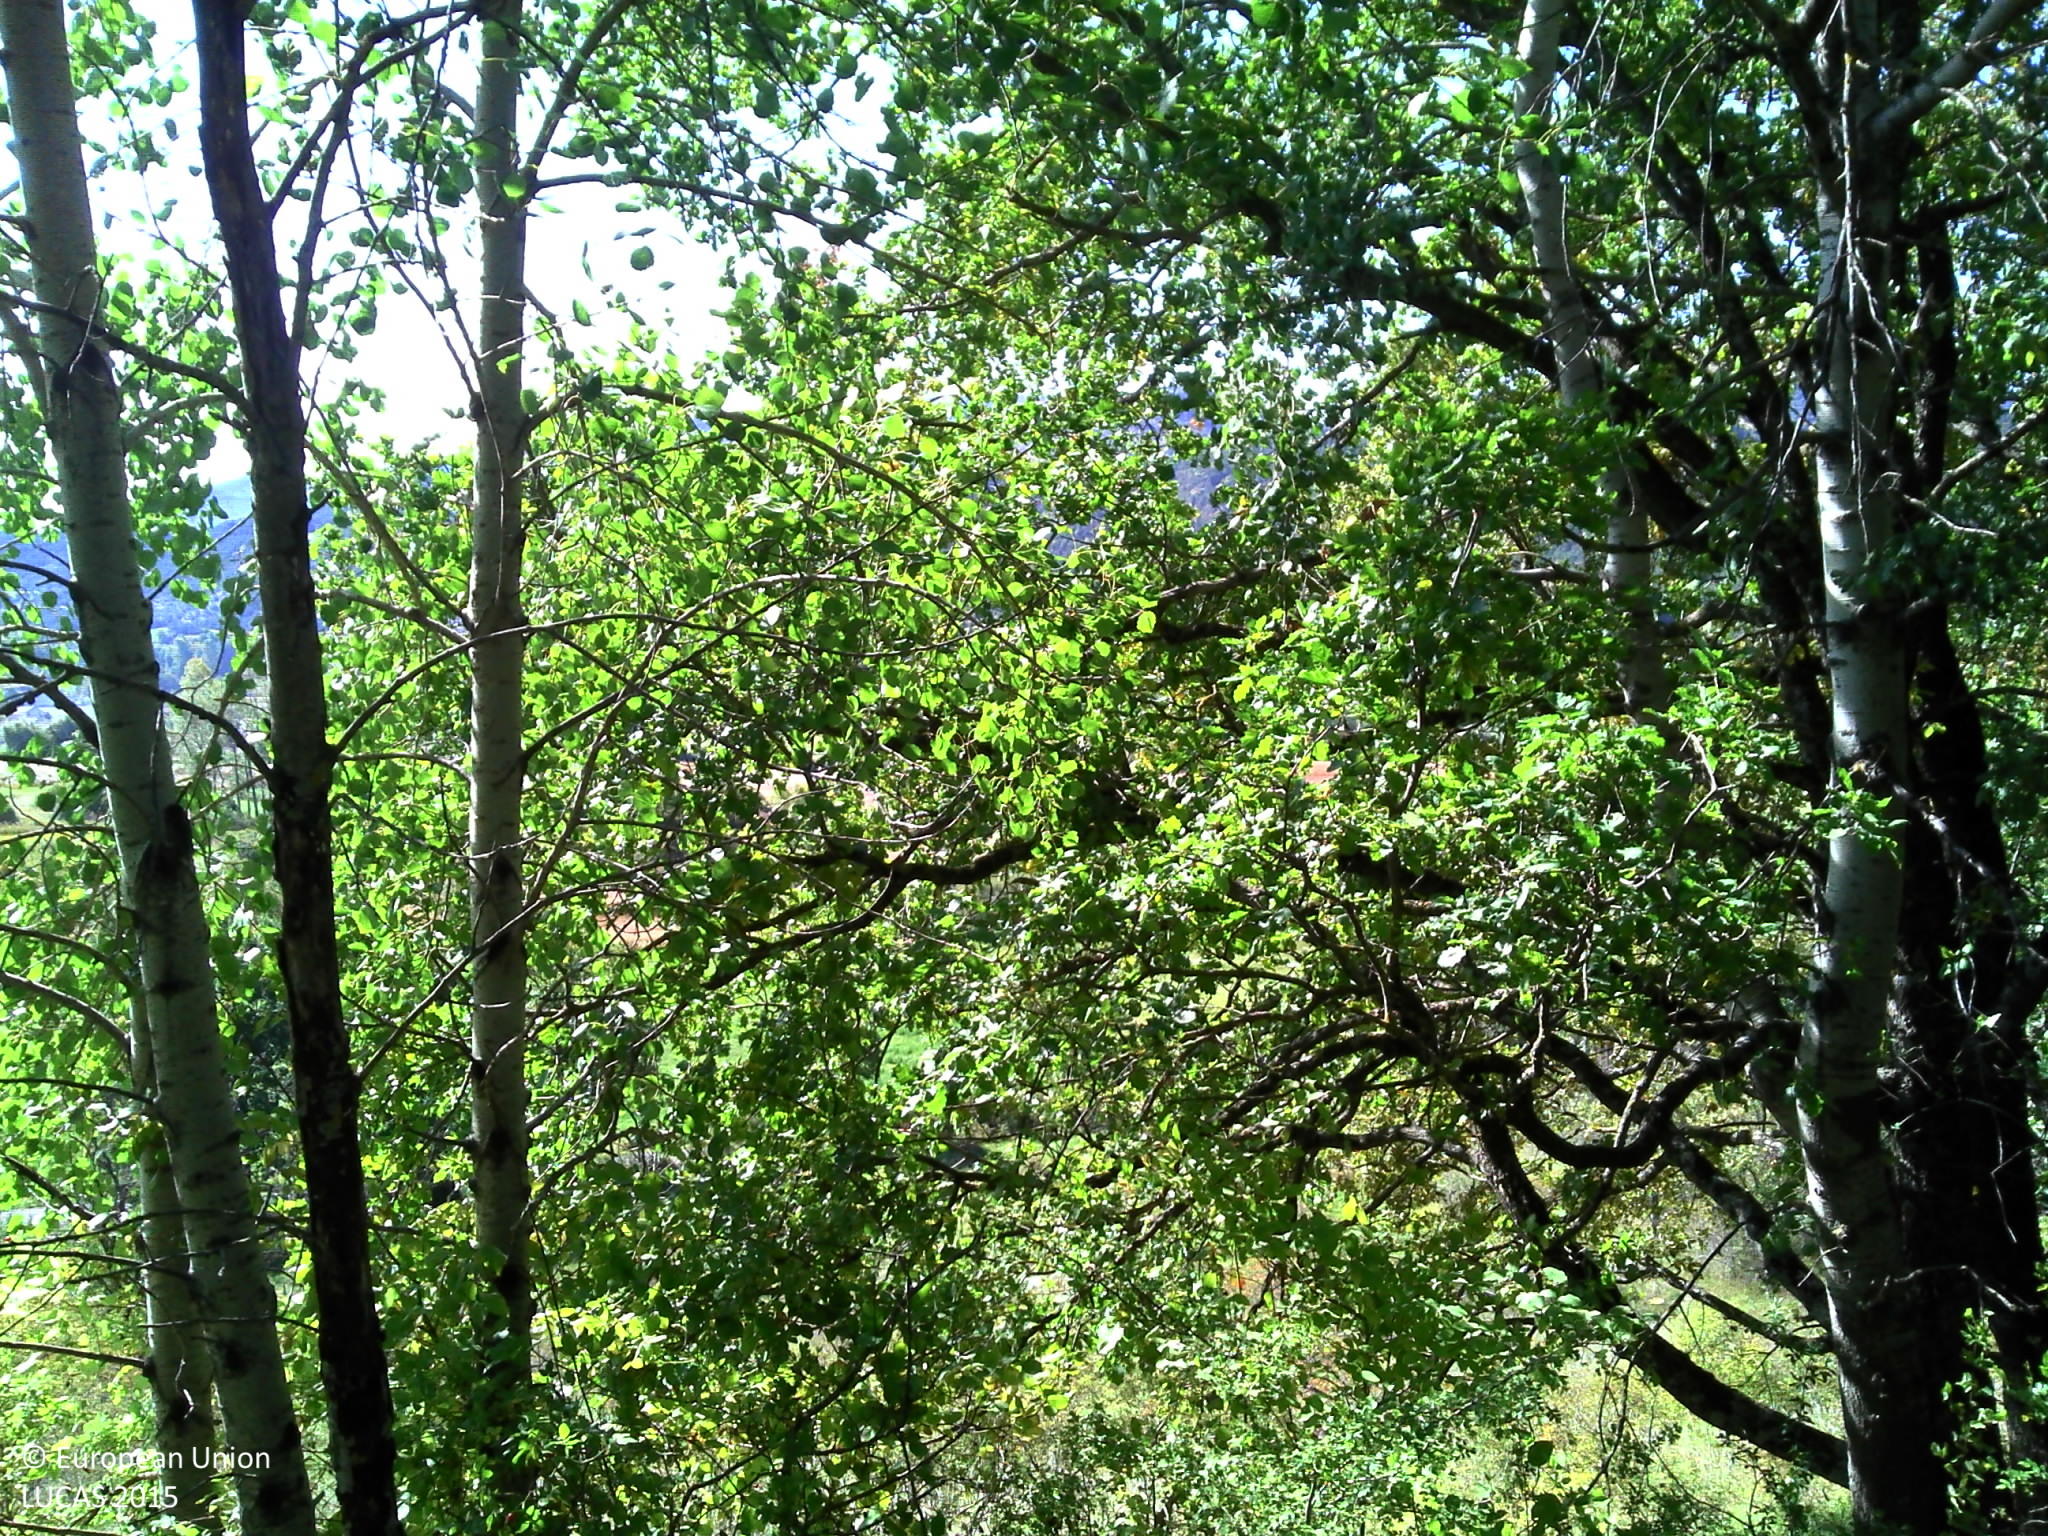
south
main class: Woodland
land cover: Broadleaved woodland
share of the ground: 25 - 50 %
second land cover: Grassland without tree/shrub cover
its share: > 75 %
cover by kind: broadleaved forest trees 70 %, herbaceous plants 25 %, coniferous forest trees 5 %
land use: Forestry
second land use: Agriculture (excluding fallow land and kitchen gardens)
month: October
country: FR
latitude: 44.5542
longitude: 6.2677
